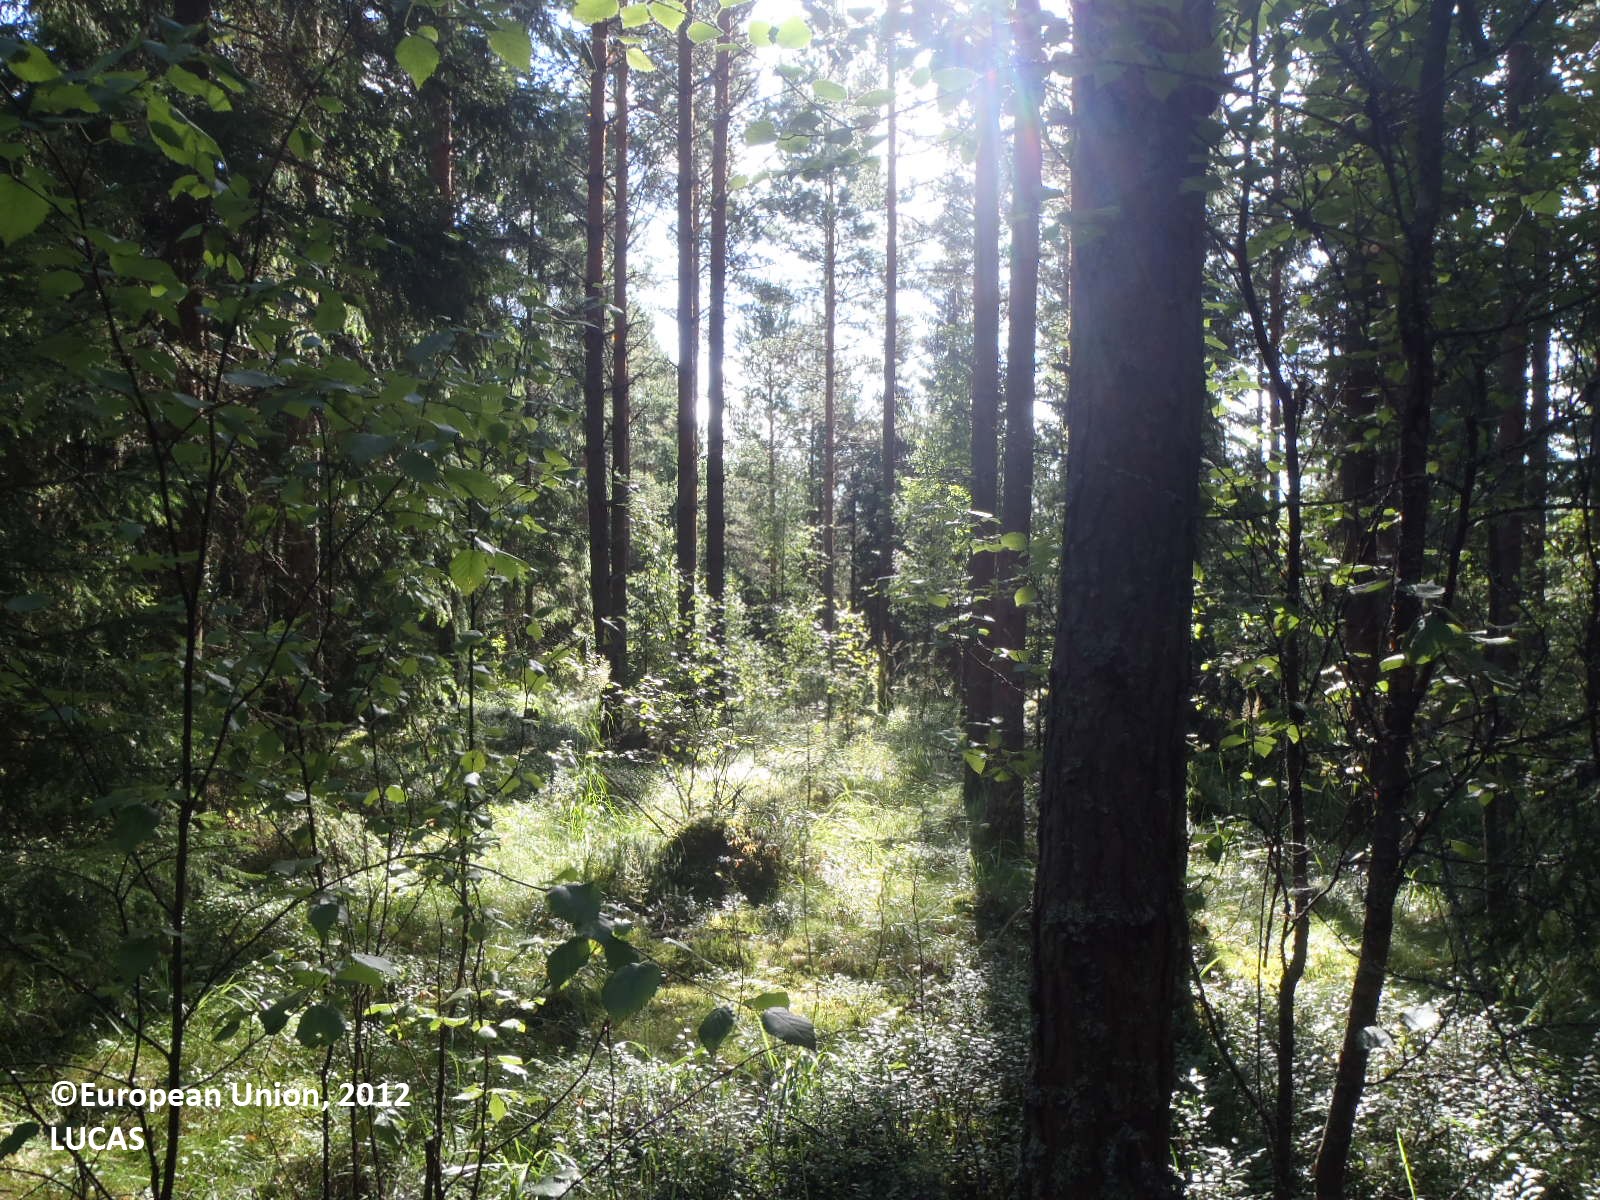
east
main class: Woodland
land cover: Pine dominated mixed woodland
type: boreal forest
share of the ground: > 75 %
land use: Forestry
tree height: > 5 m
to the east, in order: Pine dominated mixed woodland; Ditches and canals; Grass margins; Paved roads, cycling and walking lanes; Grass margins; Pine dominated mixed woodland; Ditches and canals; Pine dominated mixed woodland; Ditches and canals; Grass margins; Rye
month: August
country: FI
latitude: 60.9376
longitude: 21.8509
